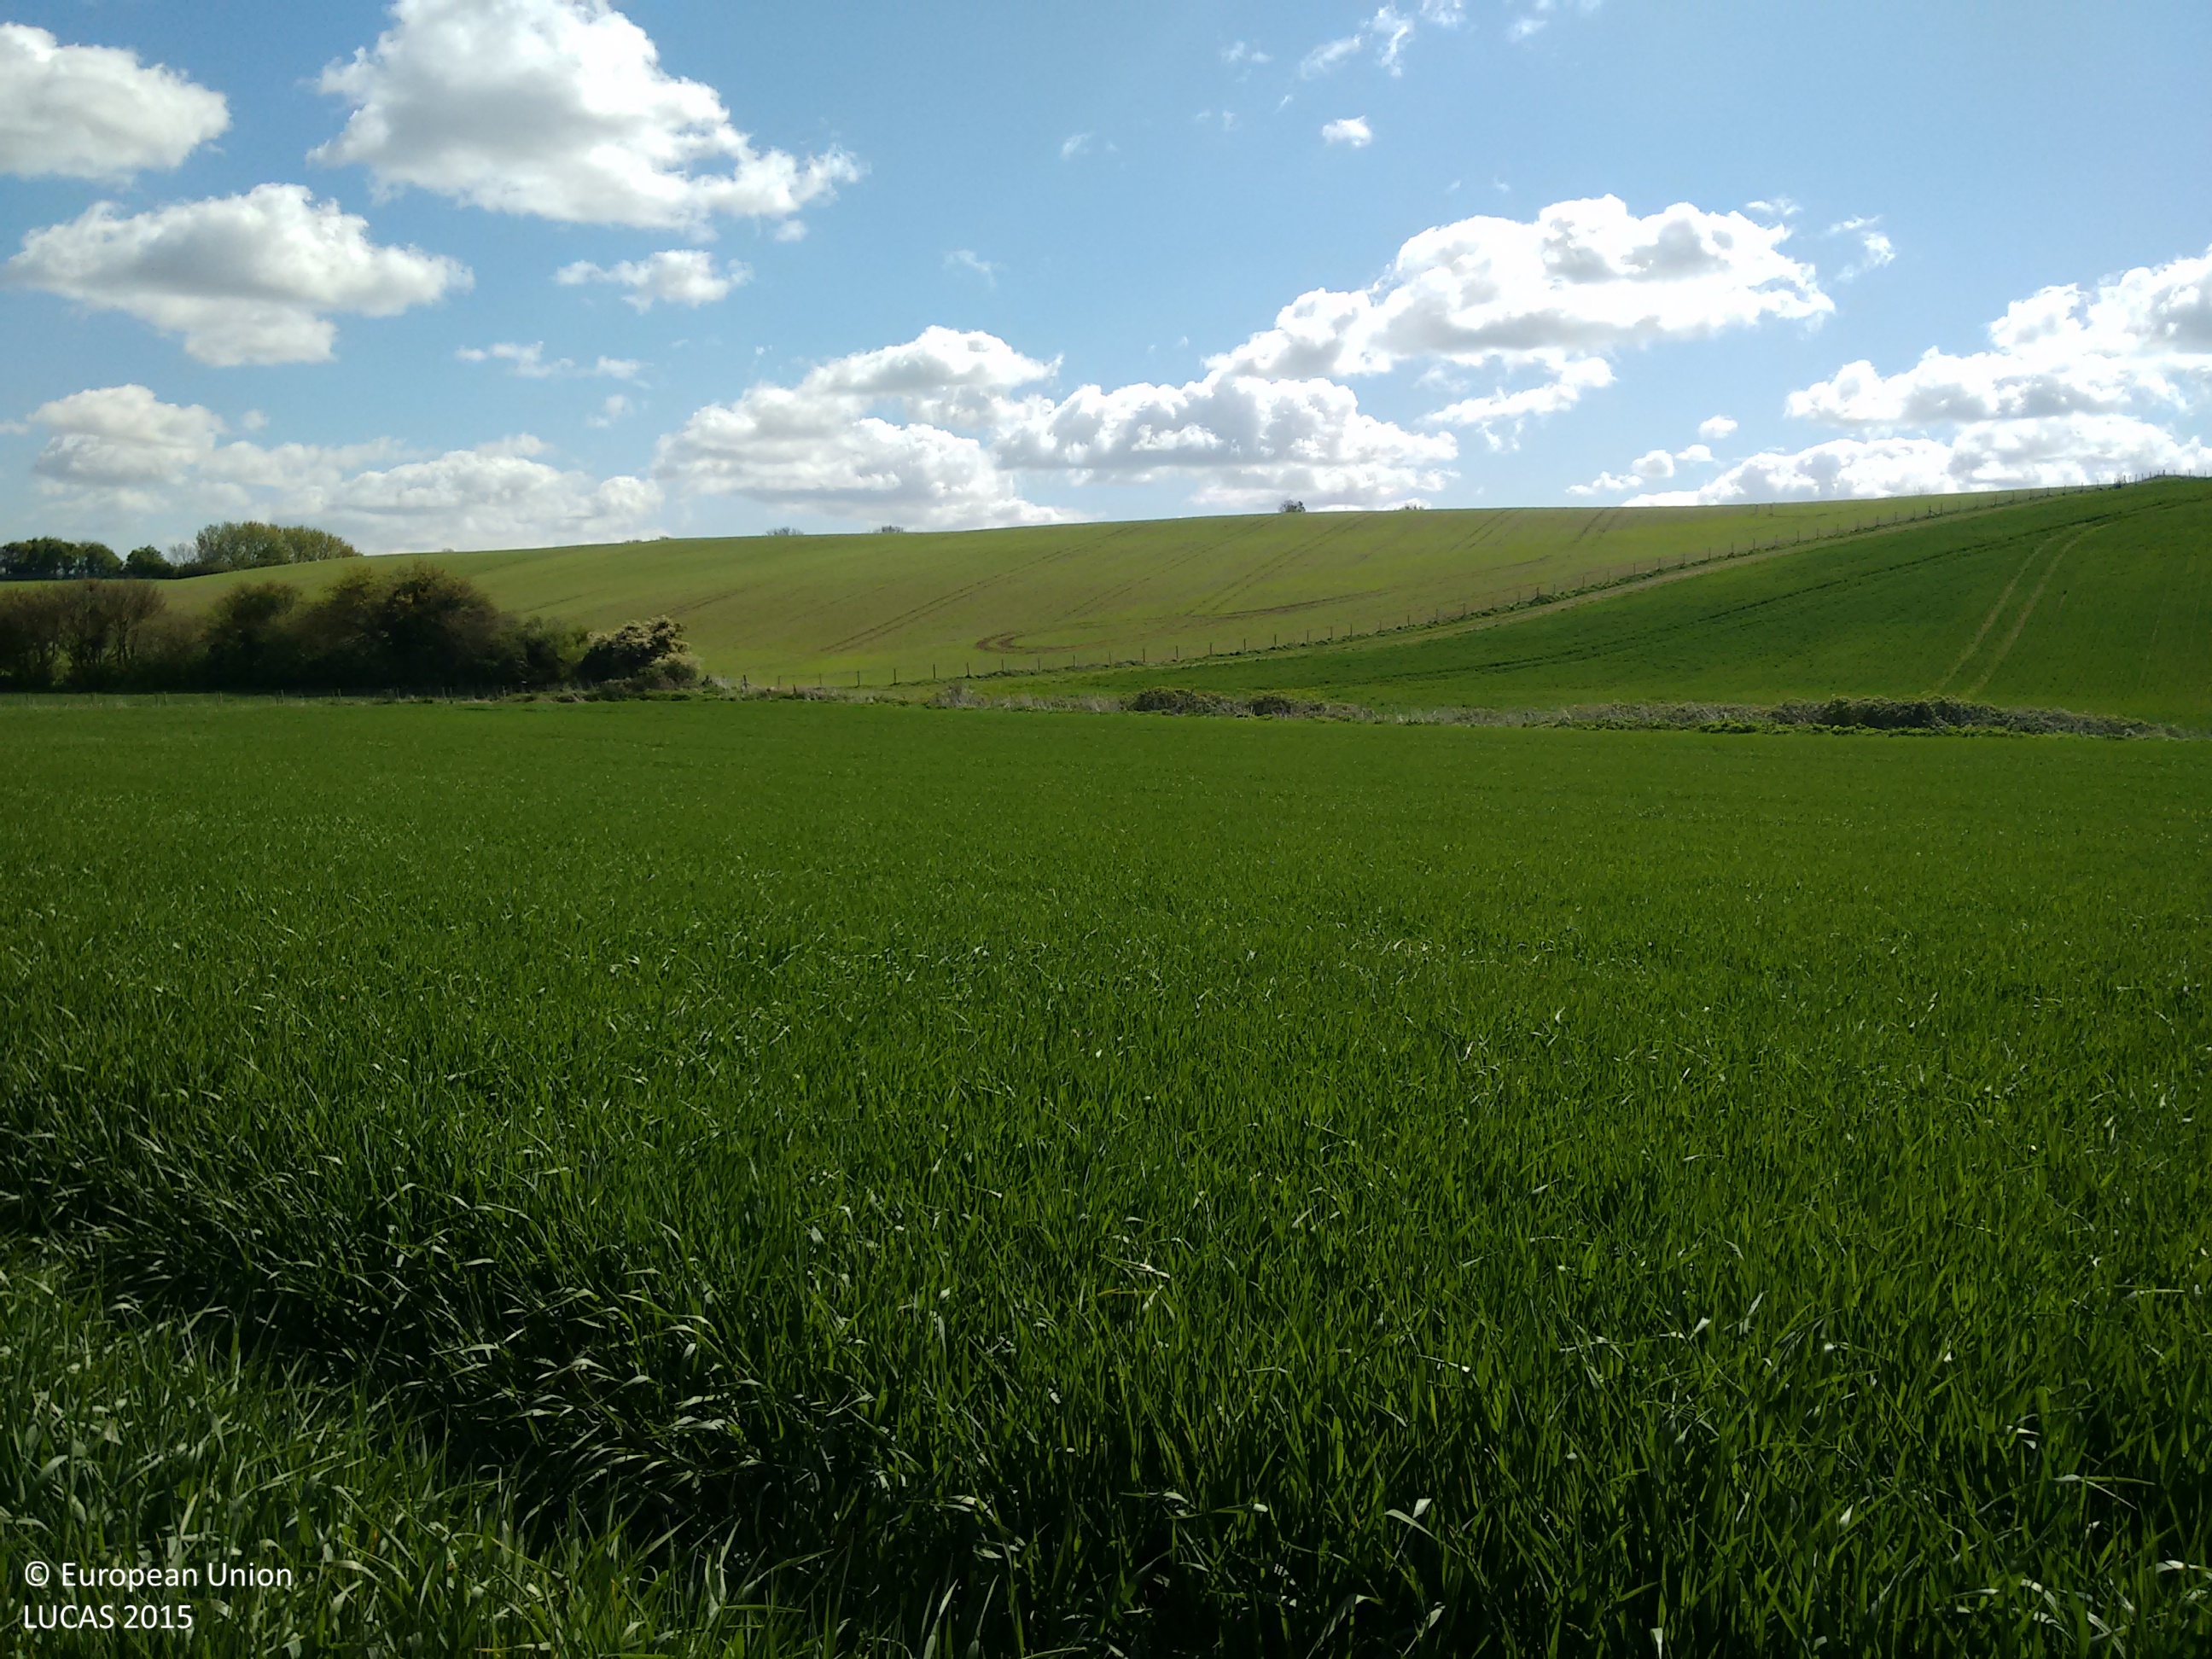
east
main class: Cropland
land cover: Barley
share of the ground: > 75 %
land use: Agriculture (excluding fallow land and kitchen gardens)
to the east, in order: Barley; Shruby margins; Fences; Tracks; Fences; Barley; Fences; Abandoned hedges; Tracks; Fences; Common wheat
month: April
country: GB
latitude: 51.3276
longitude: 0.7465
